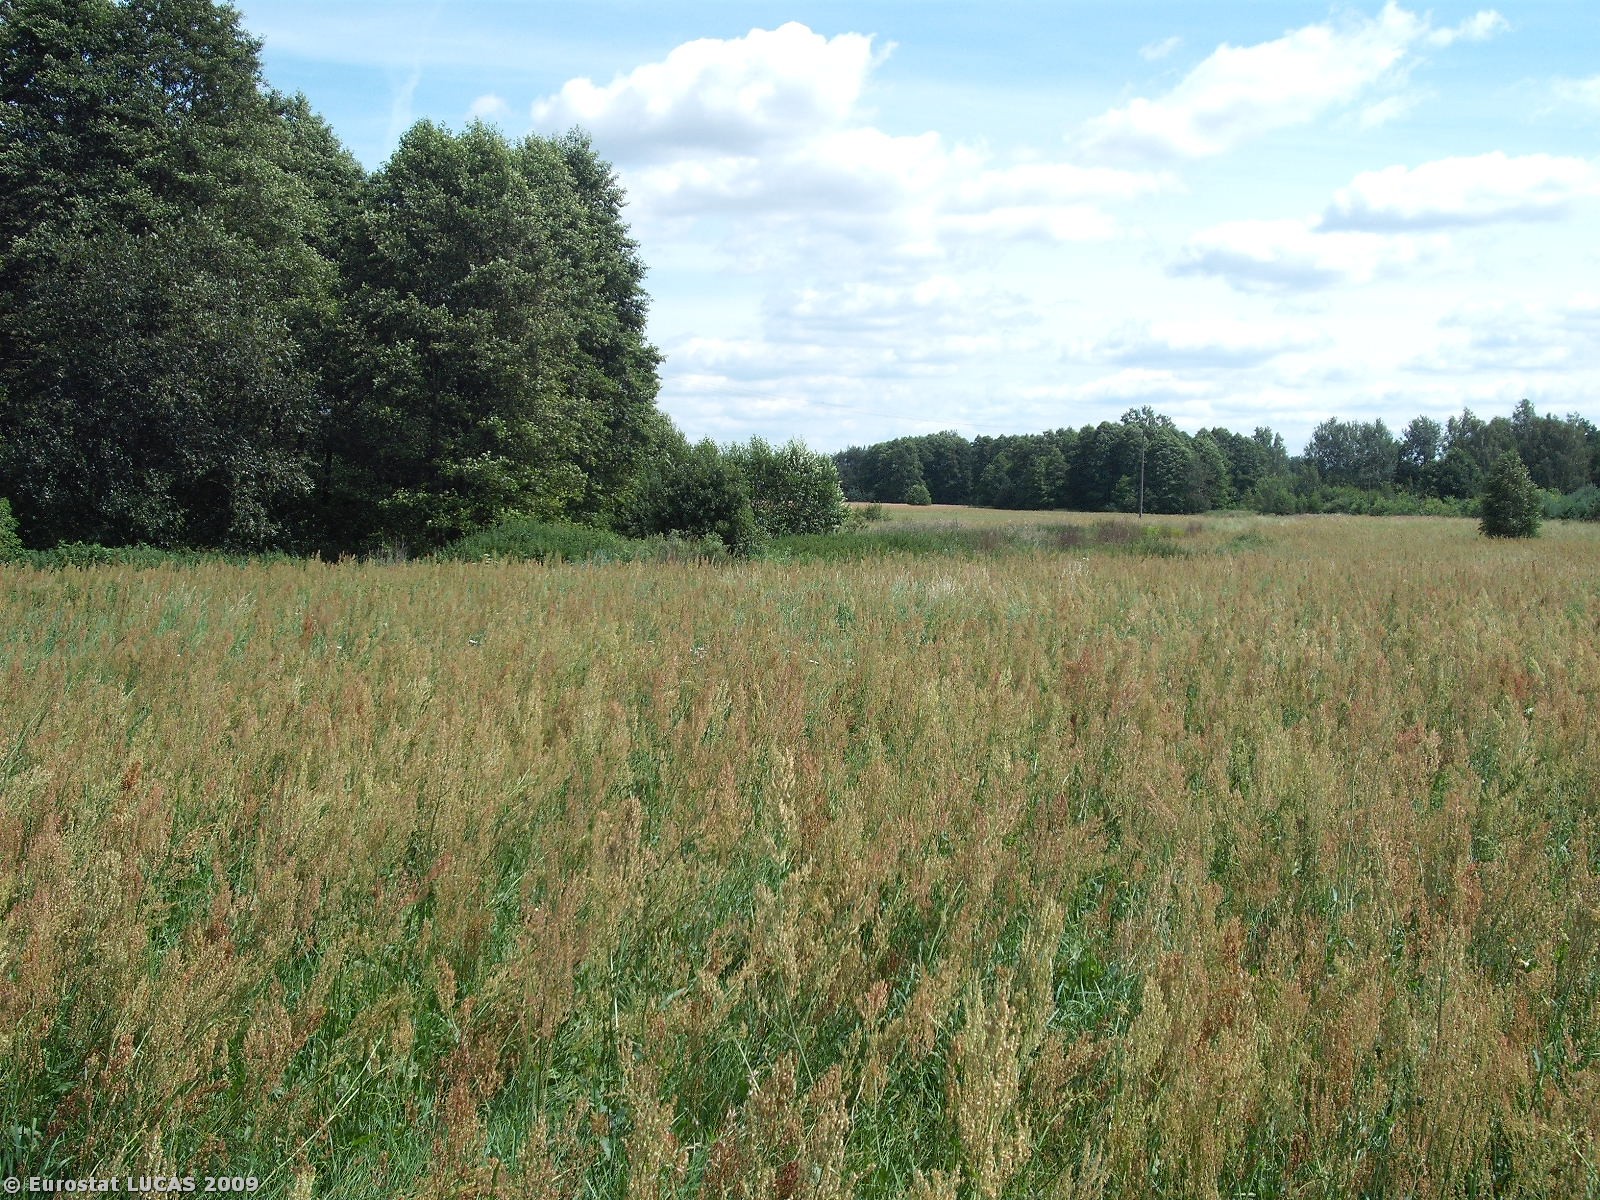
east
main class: Grassland
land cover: Grassland without tree/shrub cover
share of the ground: > 75 %
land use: Agriculture (excluding fallow land and kitchen gardens)
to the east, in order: Grassland without tree/shrub cover; Ditches and canals; Grassland without tree/shrub cover; Tracks; Grassland without tree/shrub cover; Electric lines; Grassland without tree/shrub cover; Tracks; Grassland without tree/shrub cover; Oats; Tracks; Grassland without tree/shrub cover
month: July
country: PL
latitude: 51.3122
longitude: 21.4560
